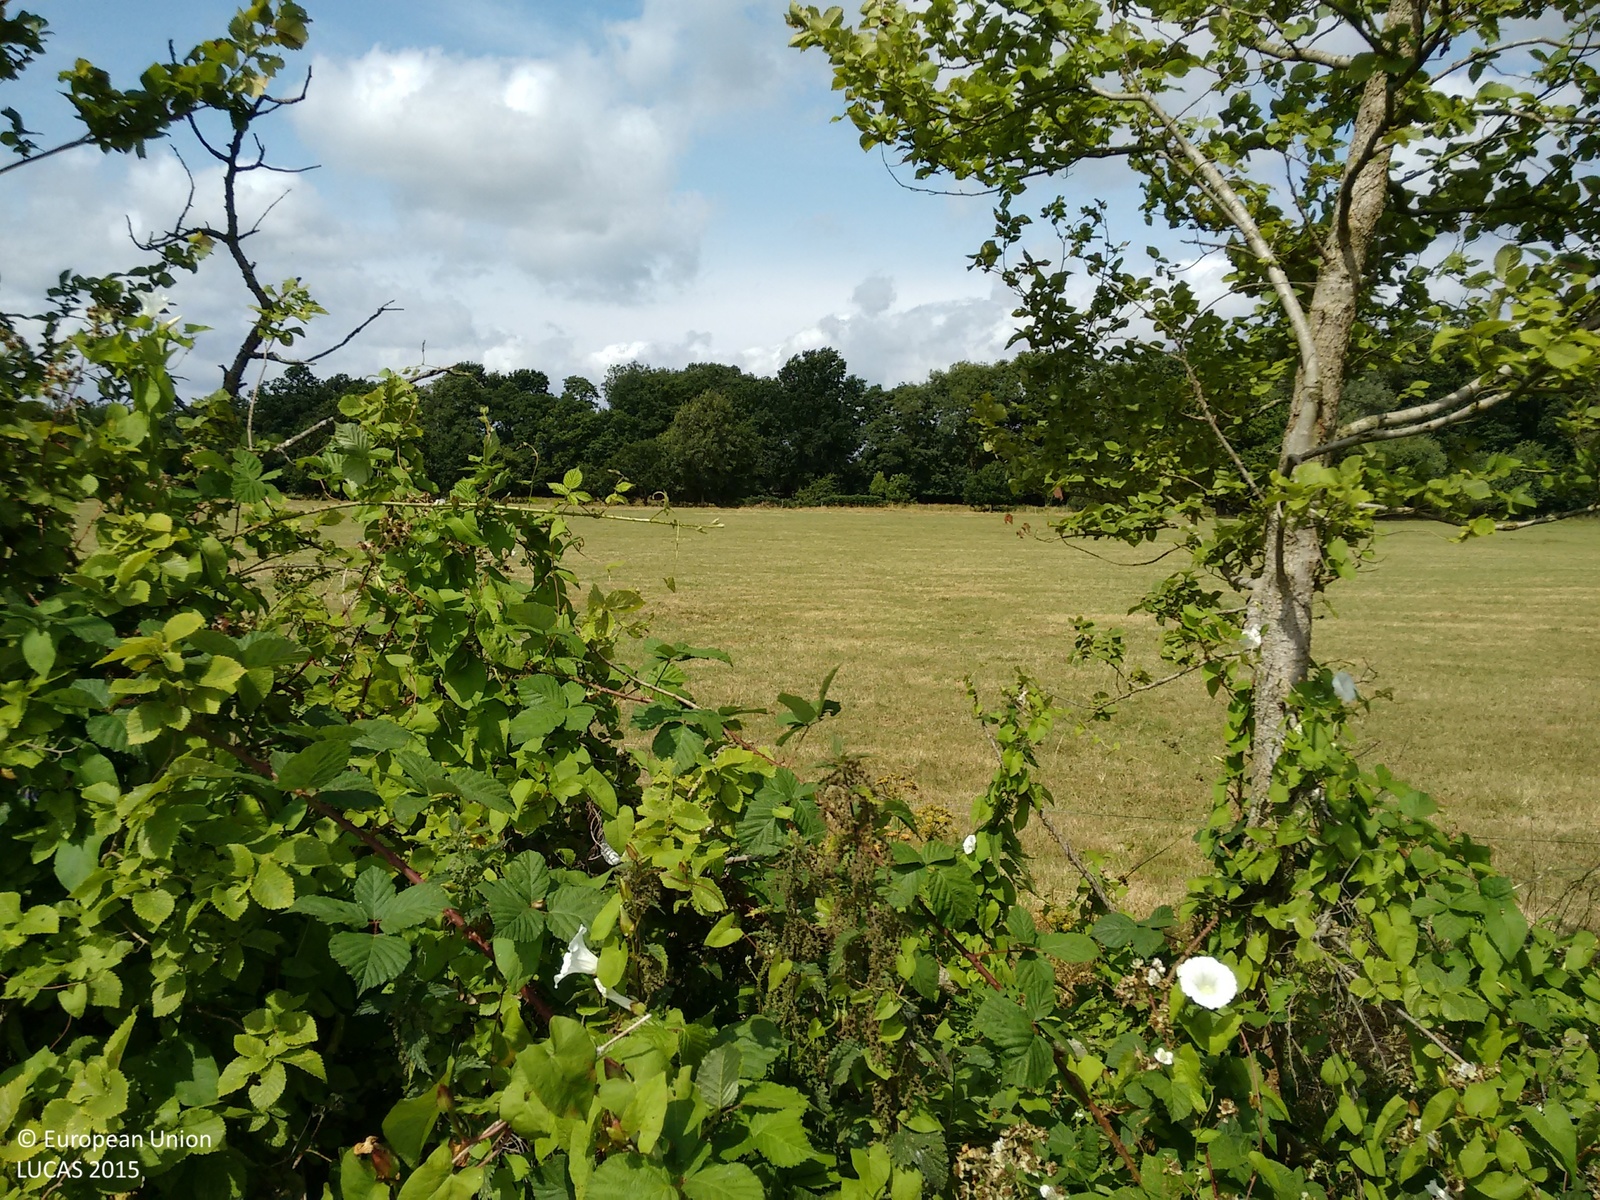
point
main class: Grassland
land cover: Grassland without tree/shrub cover
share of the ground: > 75 %
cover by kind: herbaceous plants 100 %
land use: Agriculture (excluding fallow land and kitchen gardens)
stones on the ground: < 10 %
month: July
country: GB
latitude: 51.2894
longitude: -0.5497
